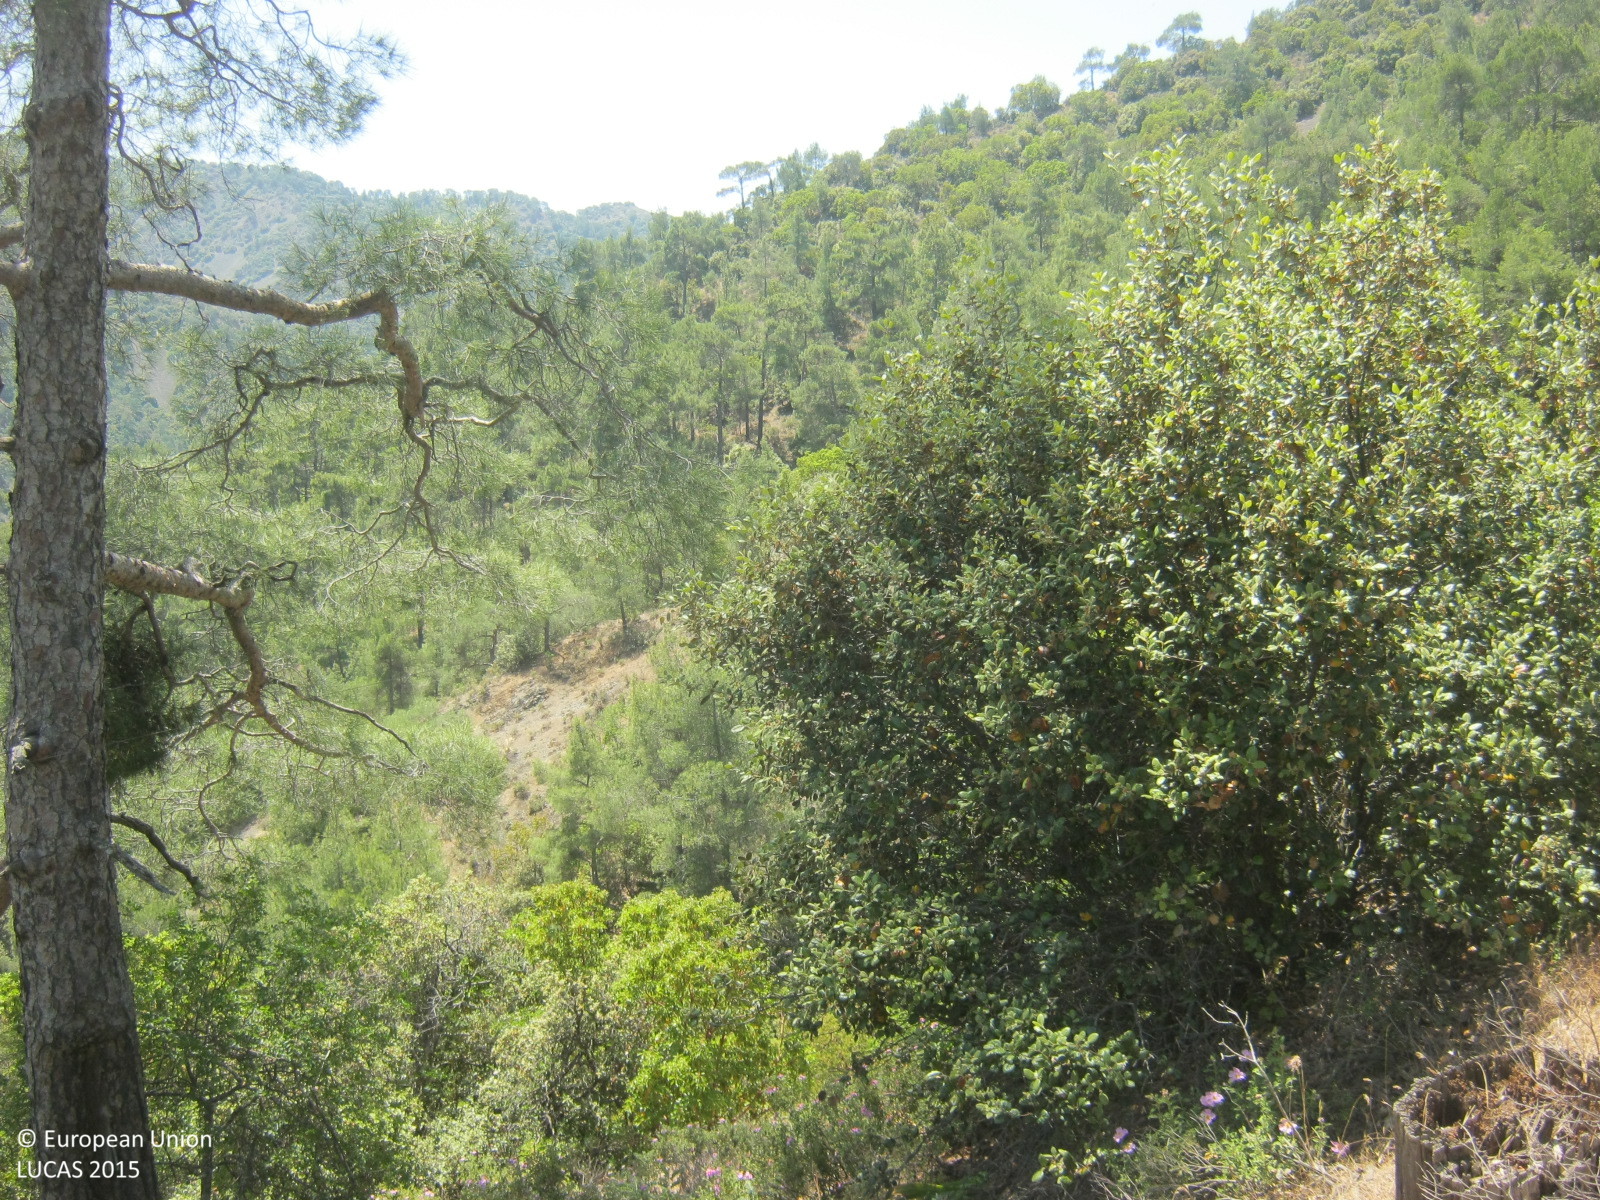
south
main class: Woodland
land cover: Pine dominated mixed woodland
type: coniferous forest of the mediterranean region
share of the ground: > 75 %
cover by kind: coniferous forest trees 75 %, broadleaved forest trees 25 %
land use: Semi-natural and natural areas not in use
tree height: > 5 m
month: May
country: CY
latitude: 34.9799
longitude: 32.7851
